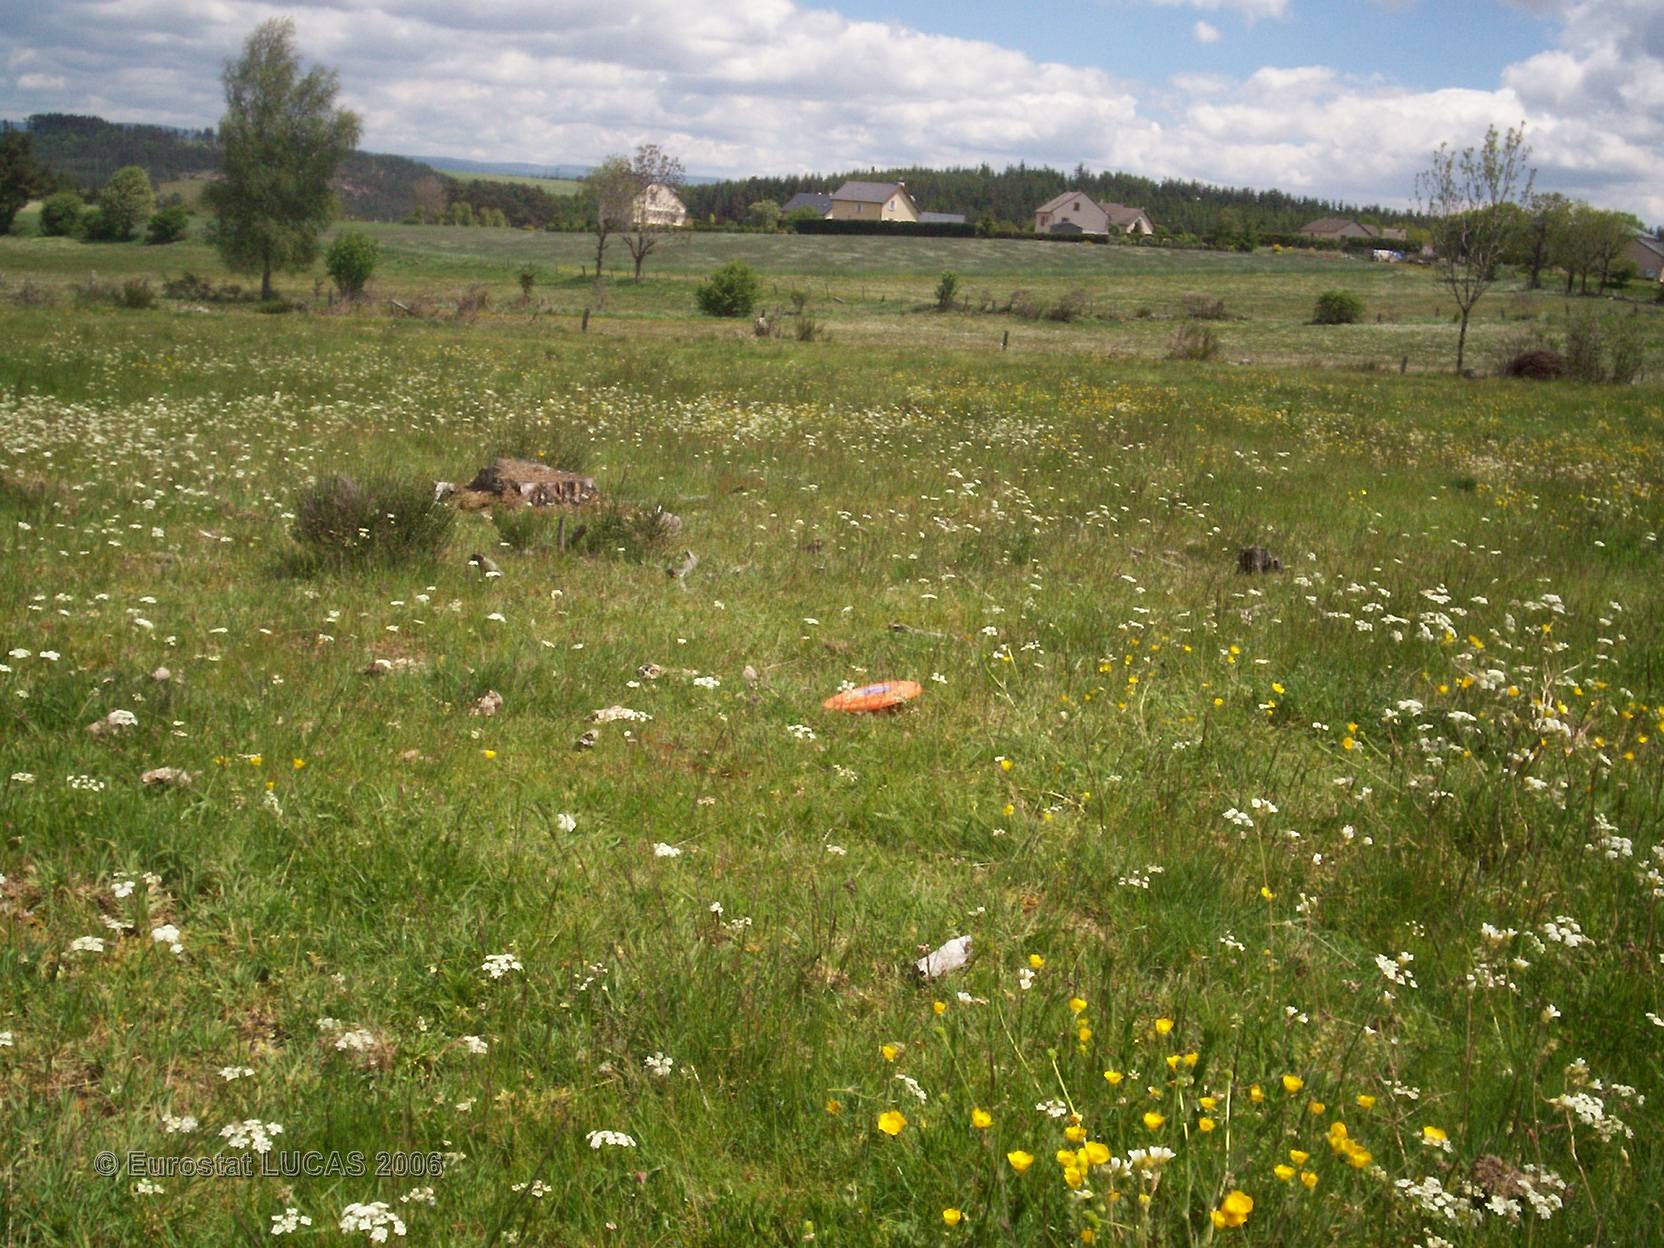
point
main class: Grassland
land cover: Grassland without tree/shrub cover
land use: Agriculture (excluding fallow land and kitchen gardens)
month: May
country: FR
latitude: 44.7667
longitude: 3.2948
